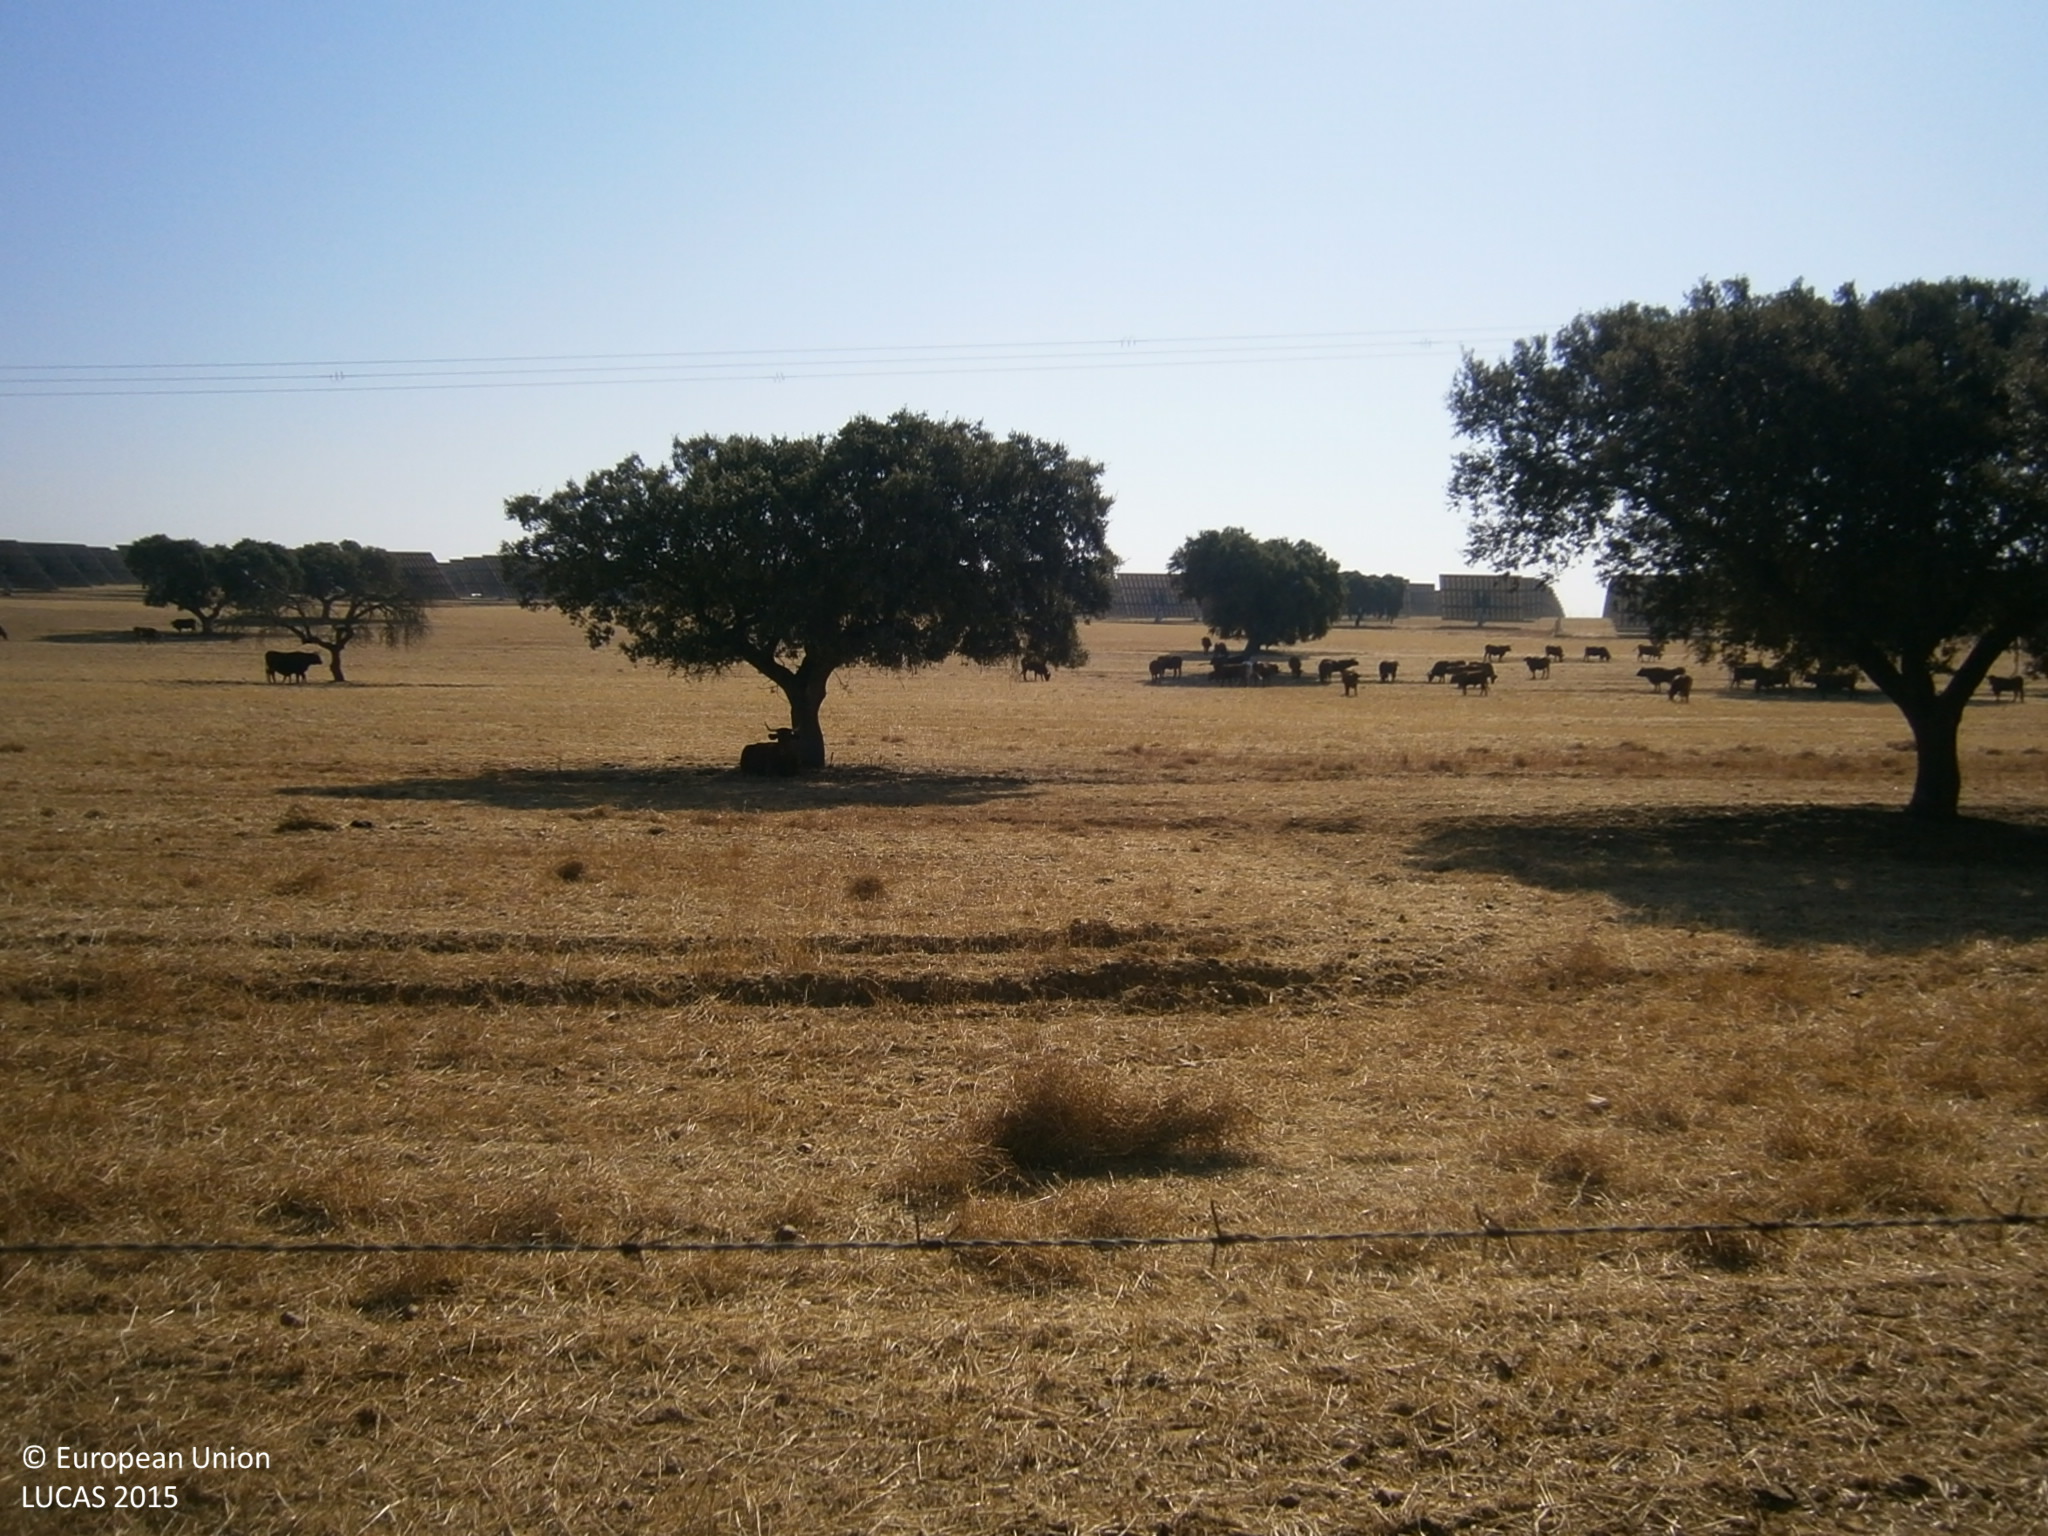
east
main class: Grassland
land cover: Grassland without tree/shrub cover
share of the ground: > 75 %
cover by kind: herbaceous plants 95 %, shrubs 5 %
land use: Agriculture (excluding fallow land and kitchen gardens)
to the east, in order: Grassland without tree/shrub cover; Grassland with sparse tree/shrub cover; Grassland without tree/shrub cover; Artificial constructions in urban areas
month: June
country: ES
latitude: 38.8154
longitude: -6.7519
